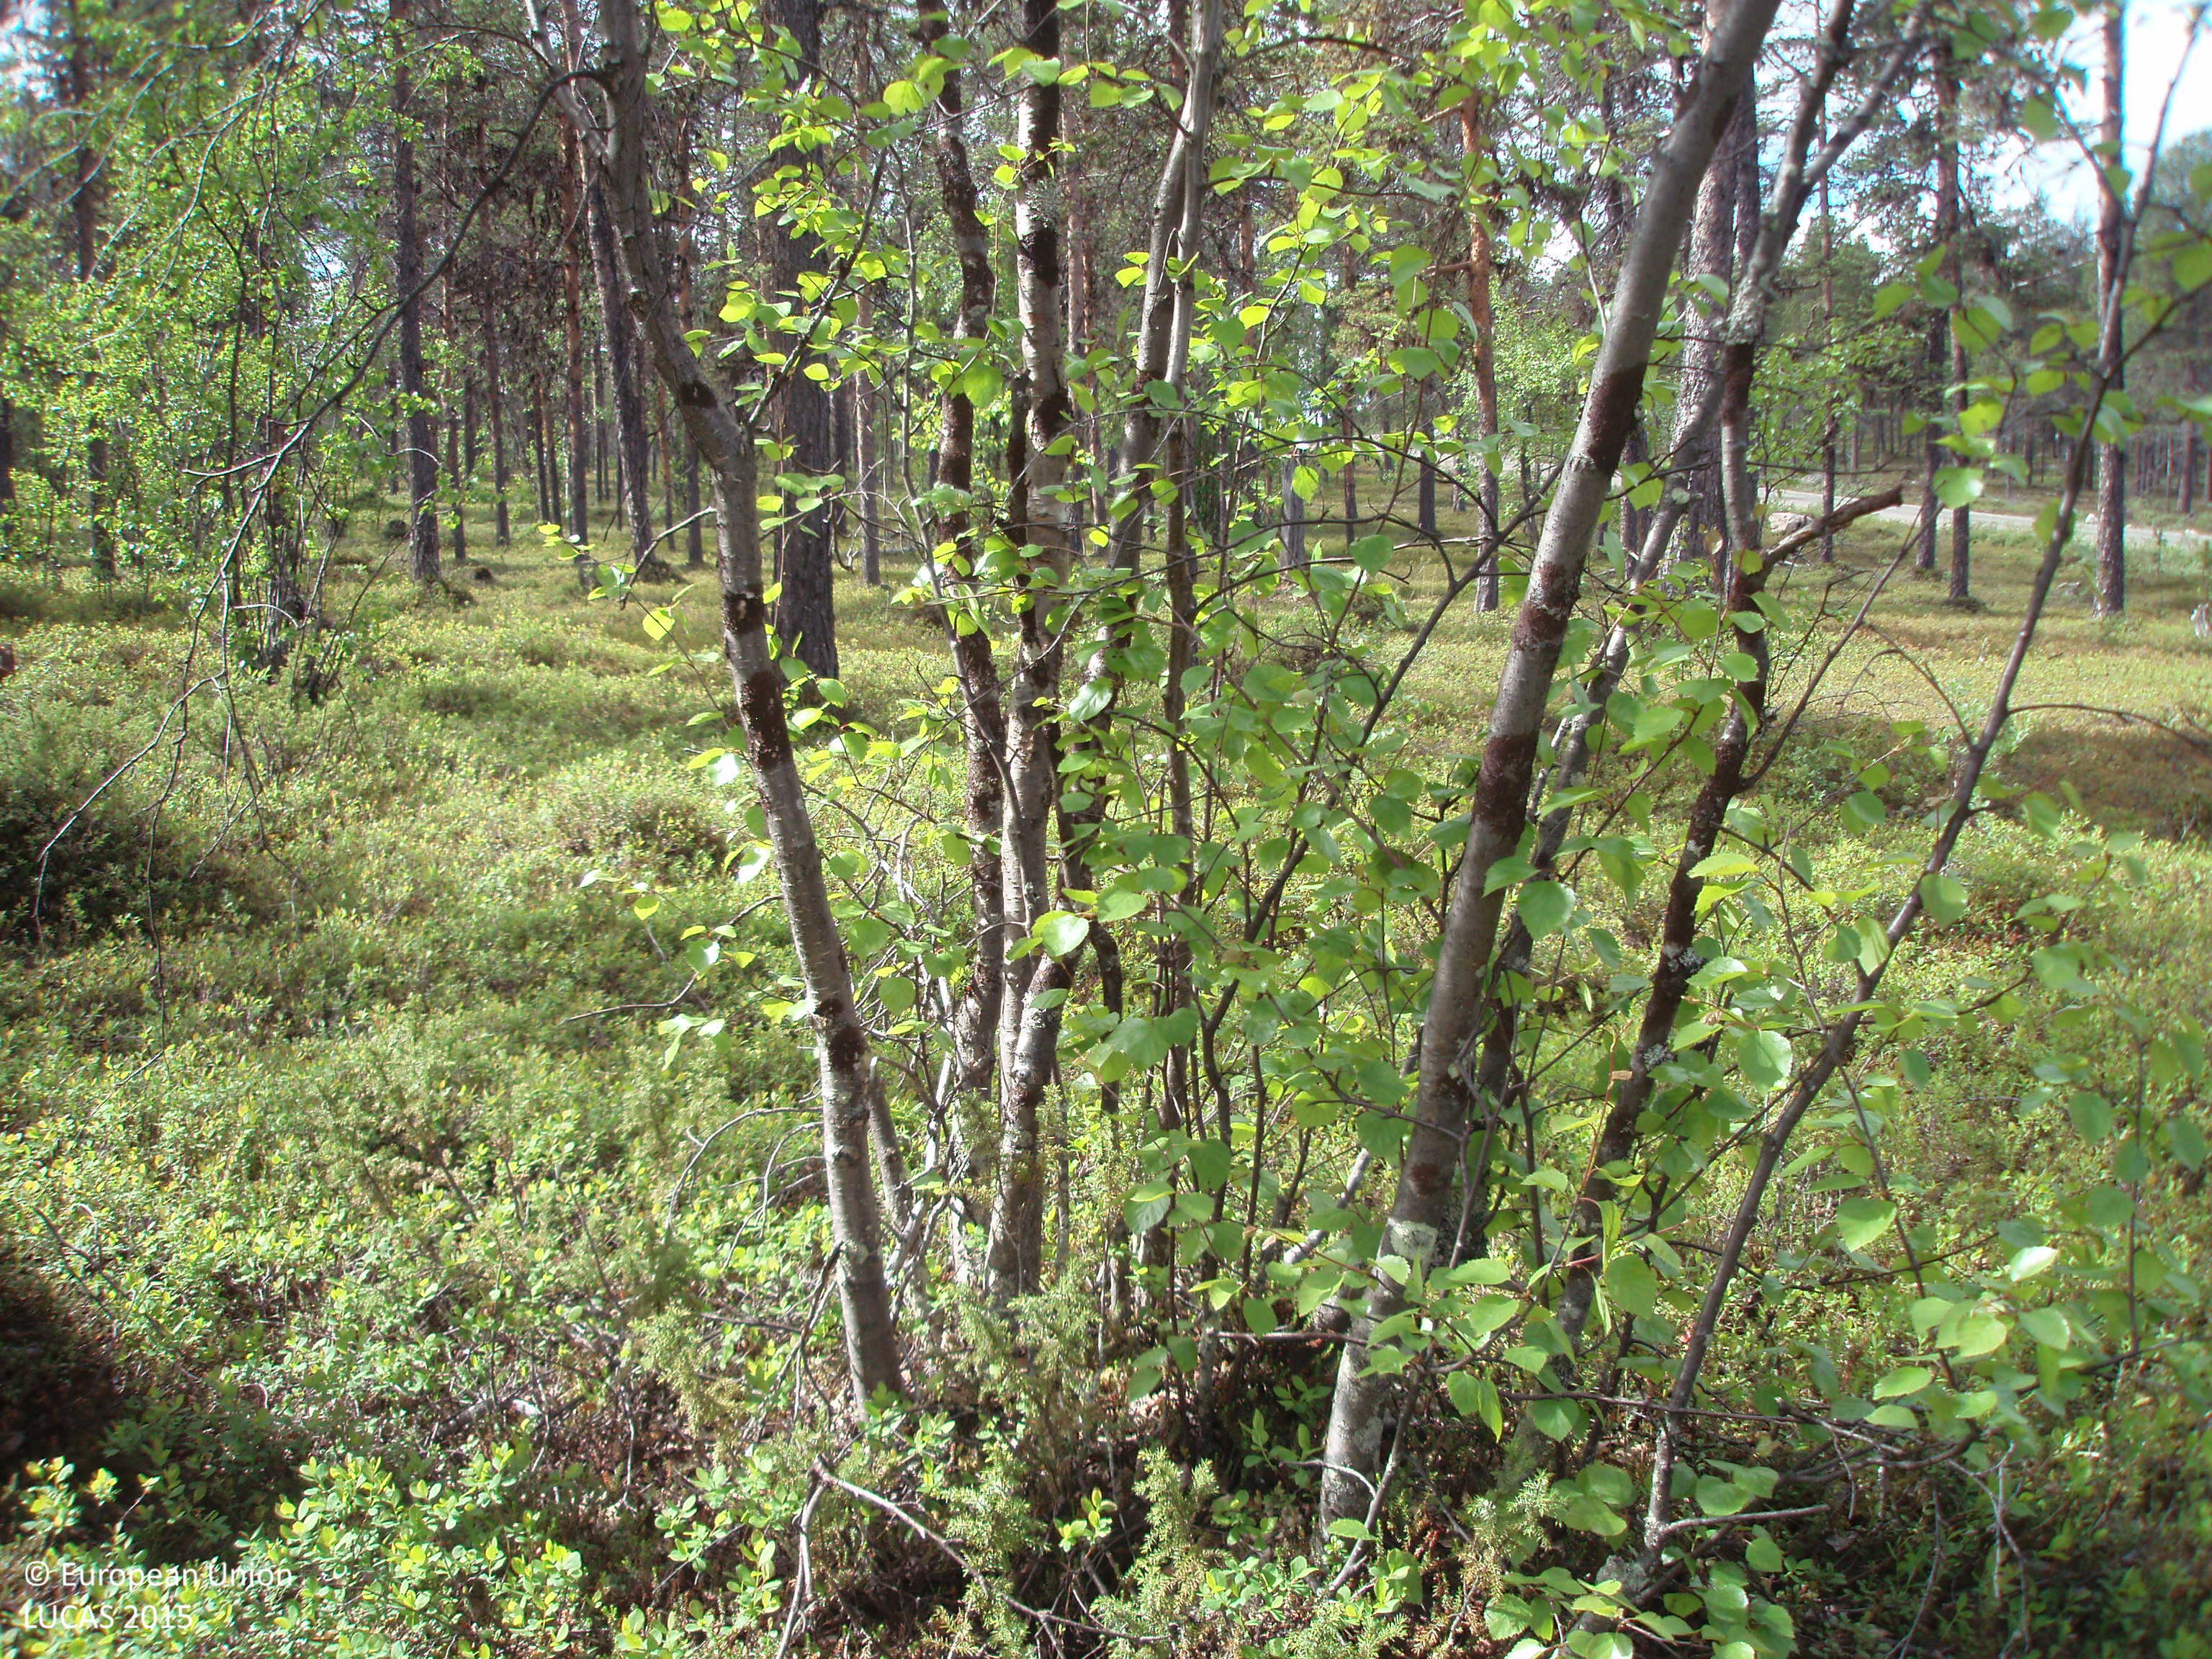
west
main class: Woodland
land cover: Pine dominated mixed woodland
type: boreal forest
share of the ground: > 75 %
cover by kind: coniferous forest trees 40 %, broadleaved forest trees 35 %, shrubs 25 %
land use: Forestry
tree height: > 5 m
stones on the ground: > 50 %
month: July
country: FI
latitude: 68.9083
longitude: 25.7938
